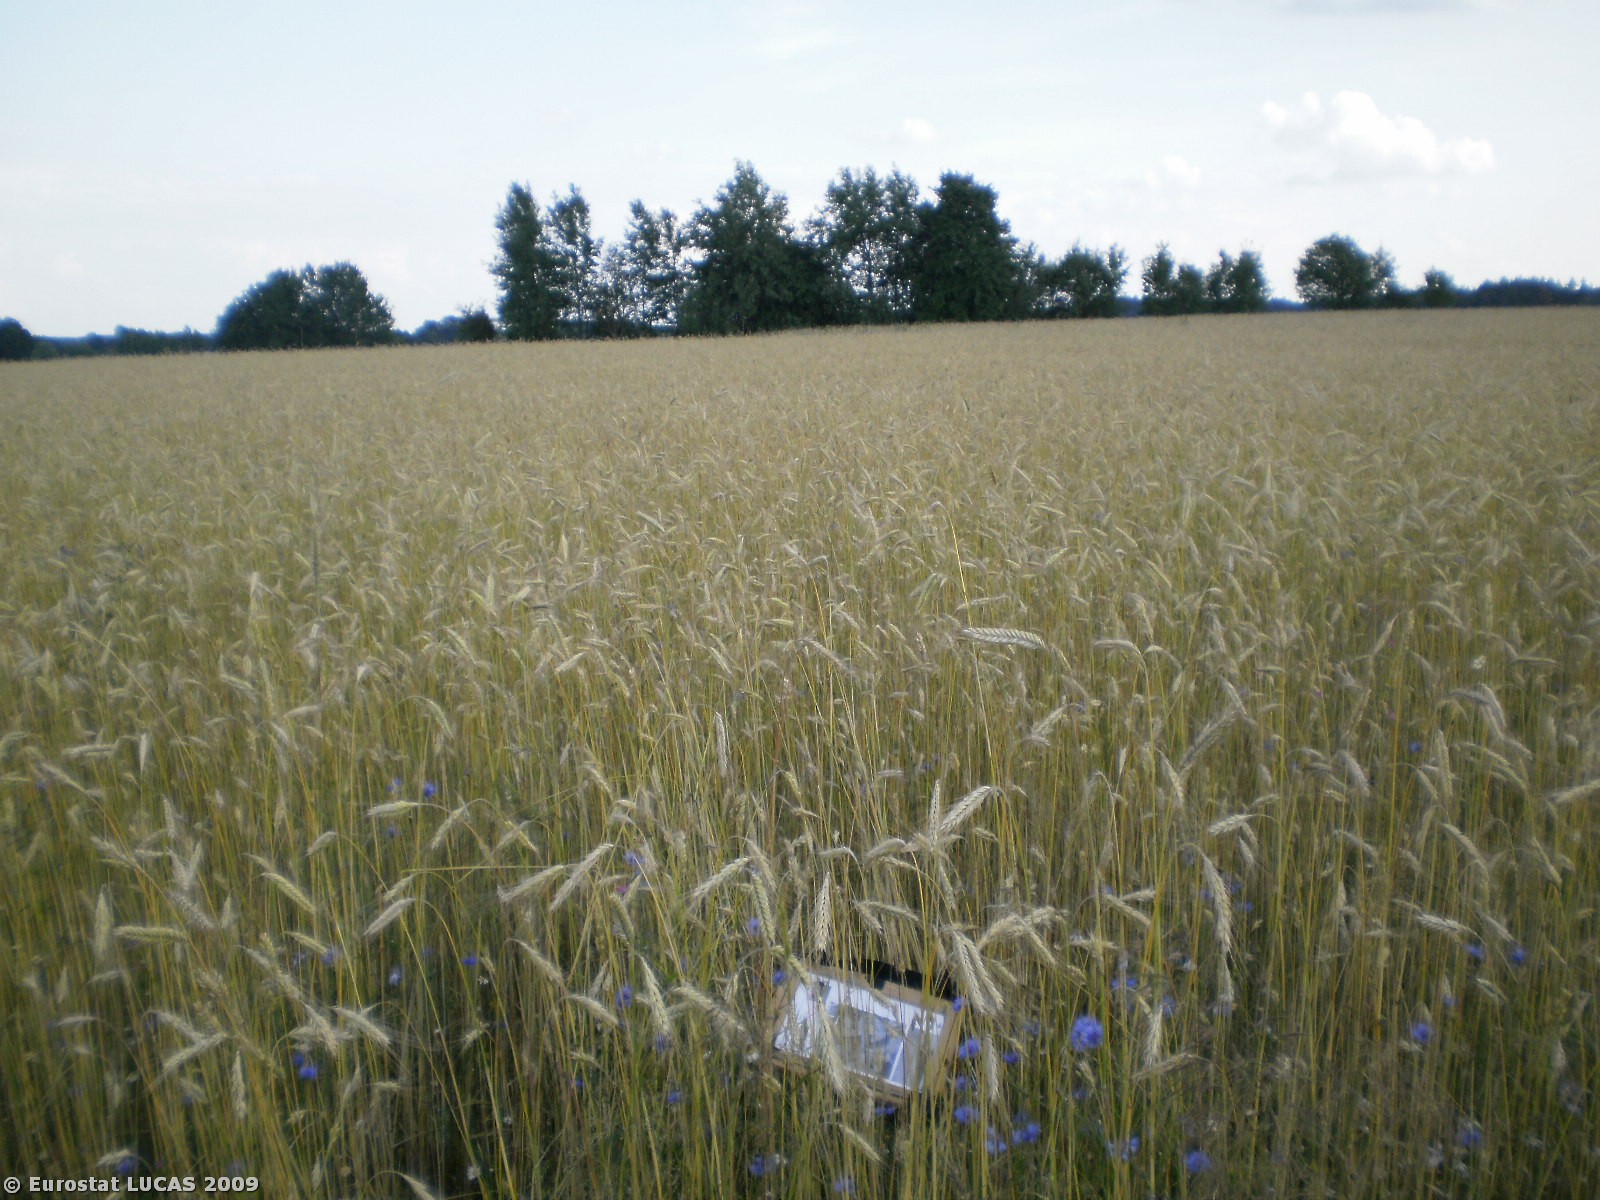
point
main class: Cropland
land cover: Triticale
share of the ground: > 75 %
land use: Agriculture (excluding fallow land and kitchen gardens)
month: July
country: PL
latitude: 53.2538
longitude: 20.4844
